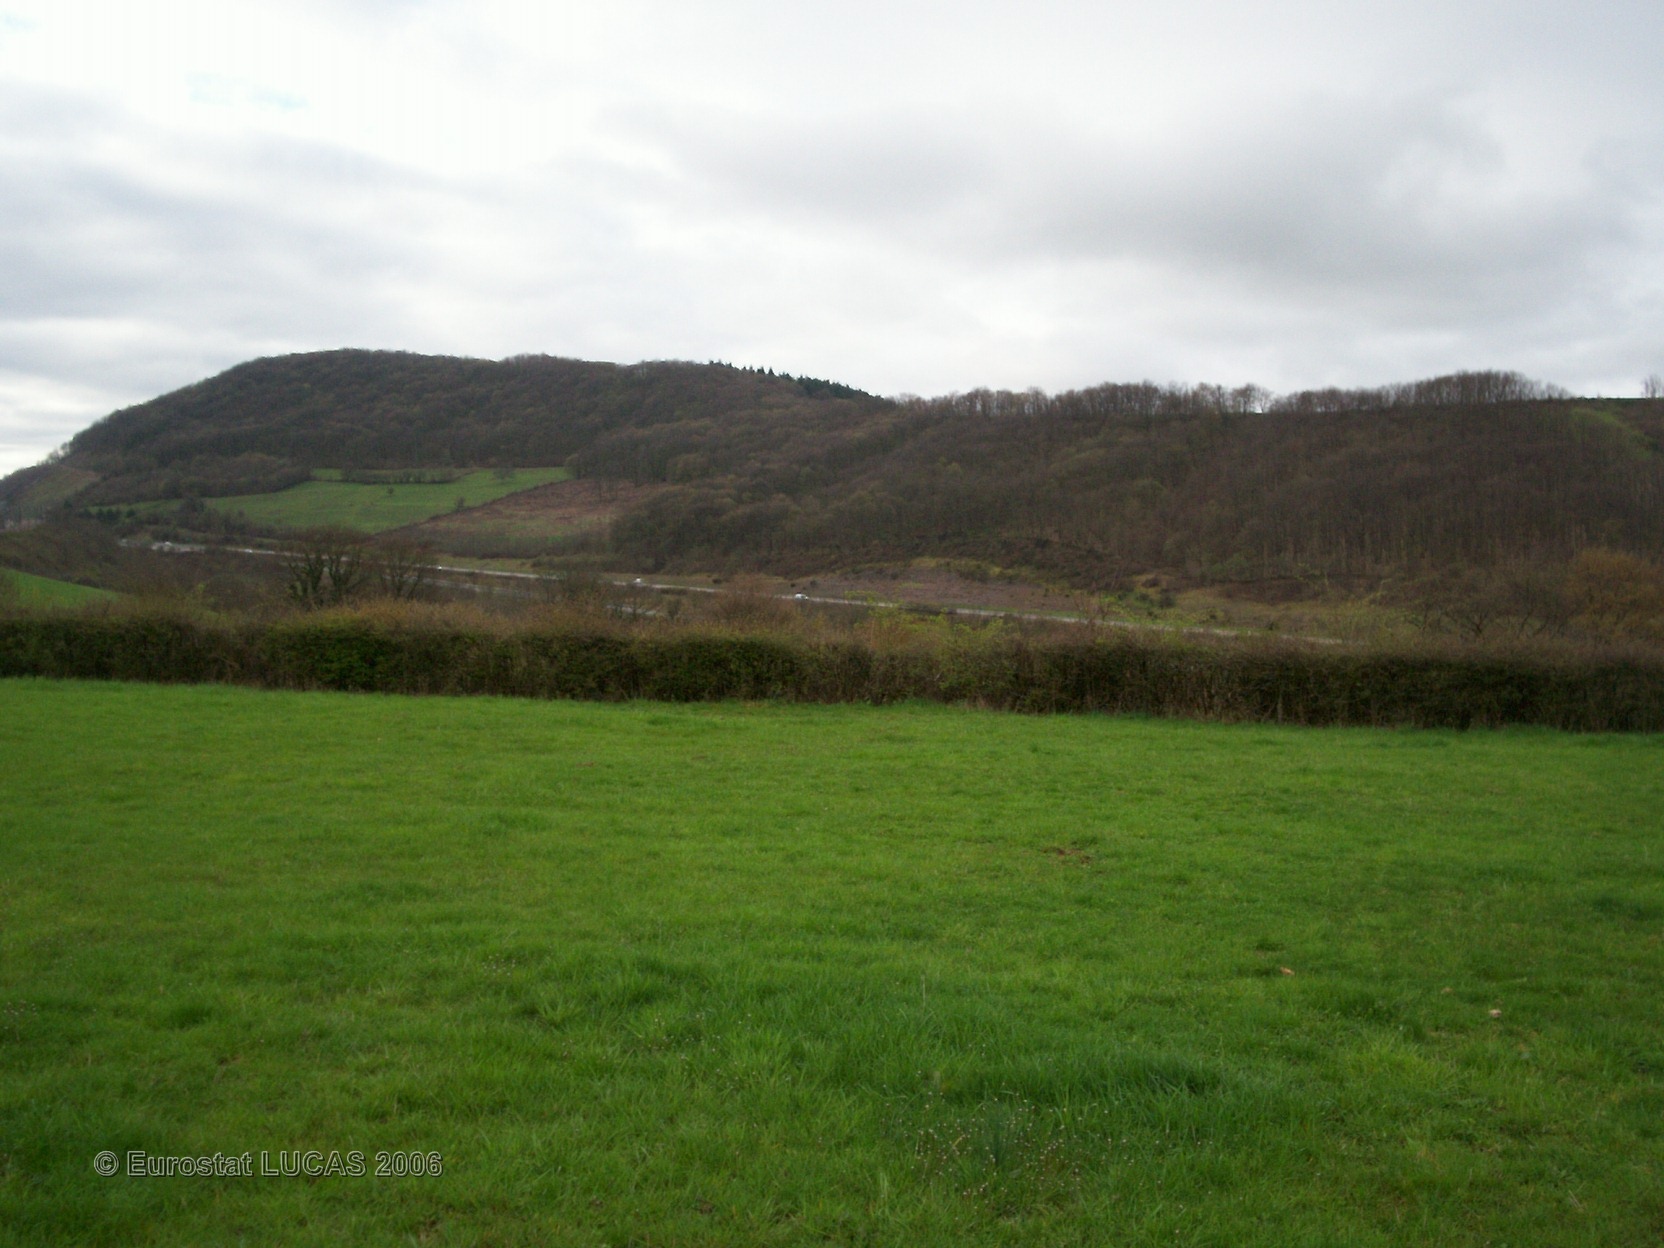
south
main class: Grassland
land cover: Grassland without tree/shrub cover
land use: Agriculture (excluding fallow land and kitchen gardens)
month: April
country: FR
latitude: 46.3982
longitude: 4.6564
